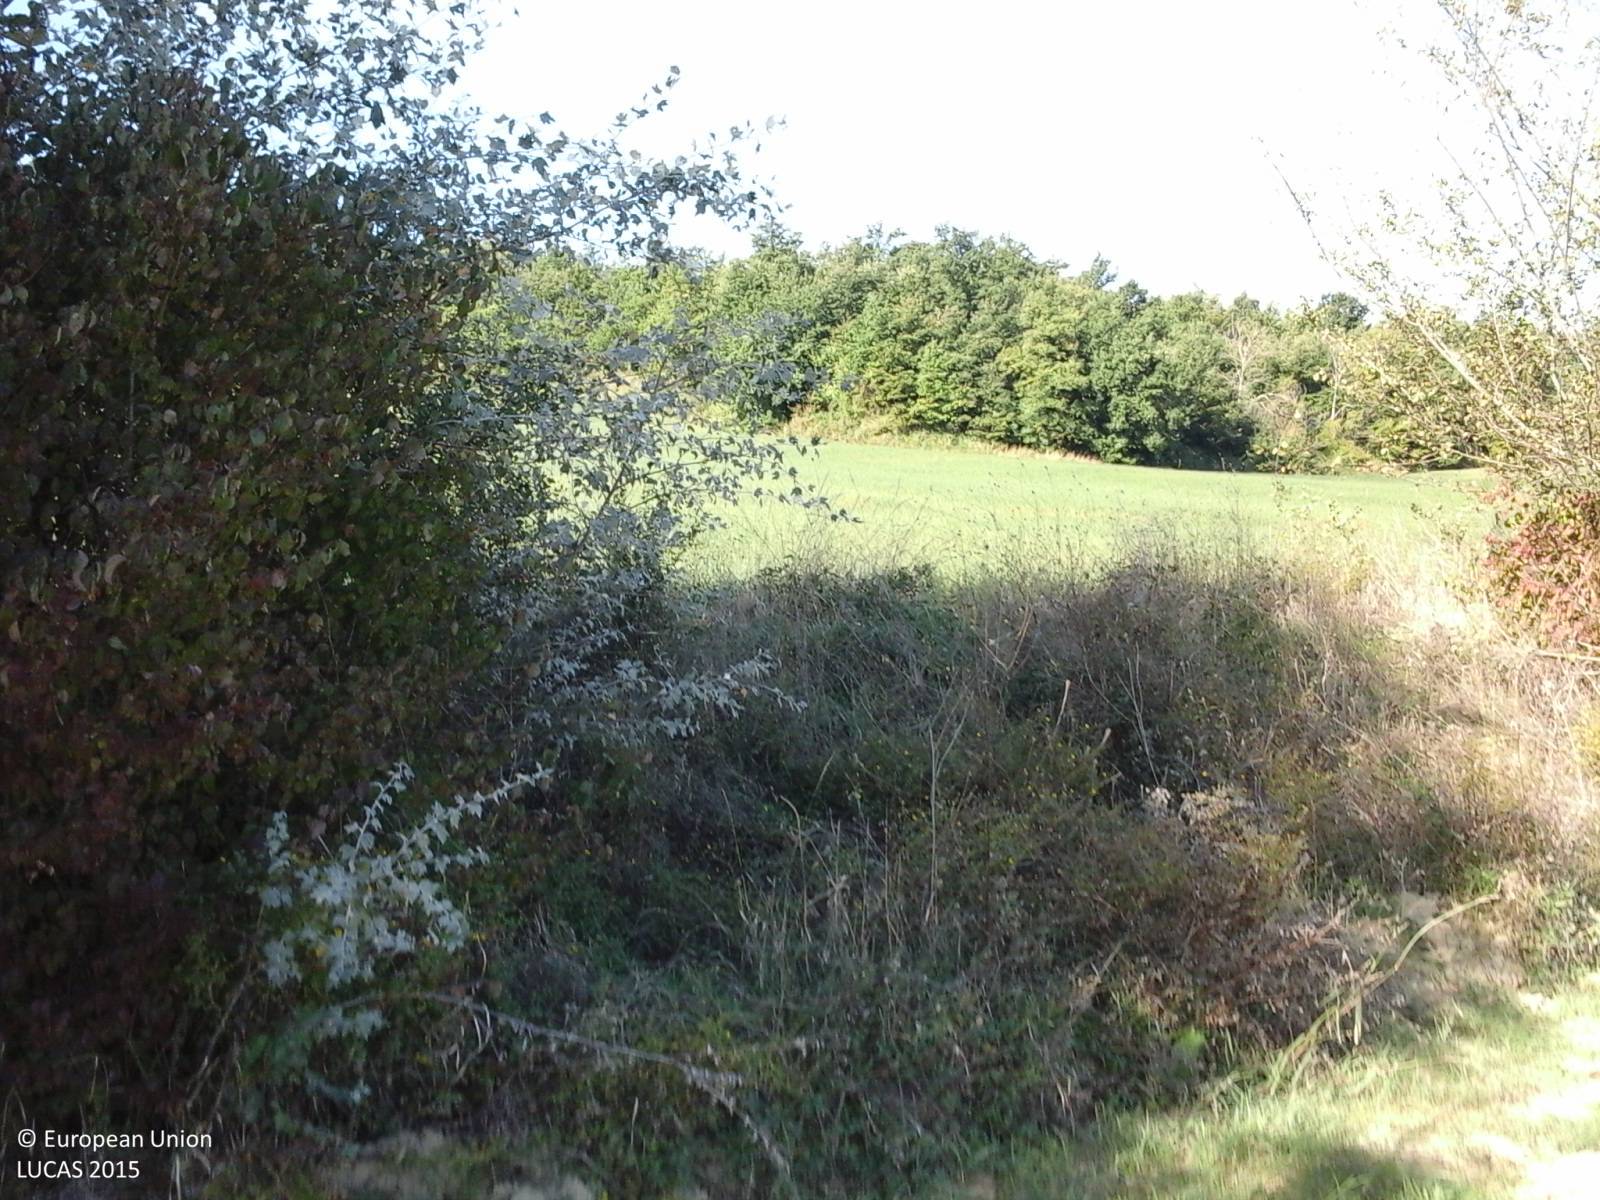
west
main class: Cropland
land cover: Lucerne
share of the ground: > 75 %
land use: Agriculture (excluding fallow land and kitchen gardens)
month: September
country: IT
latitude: 42.4813
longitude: 12.3885
